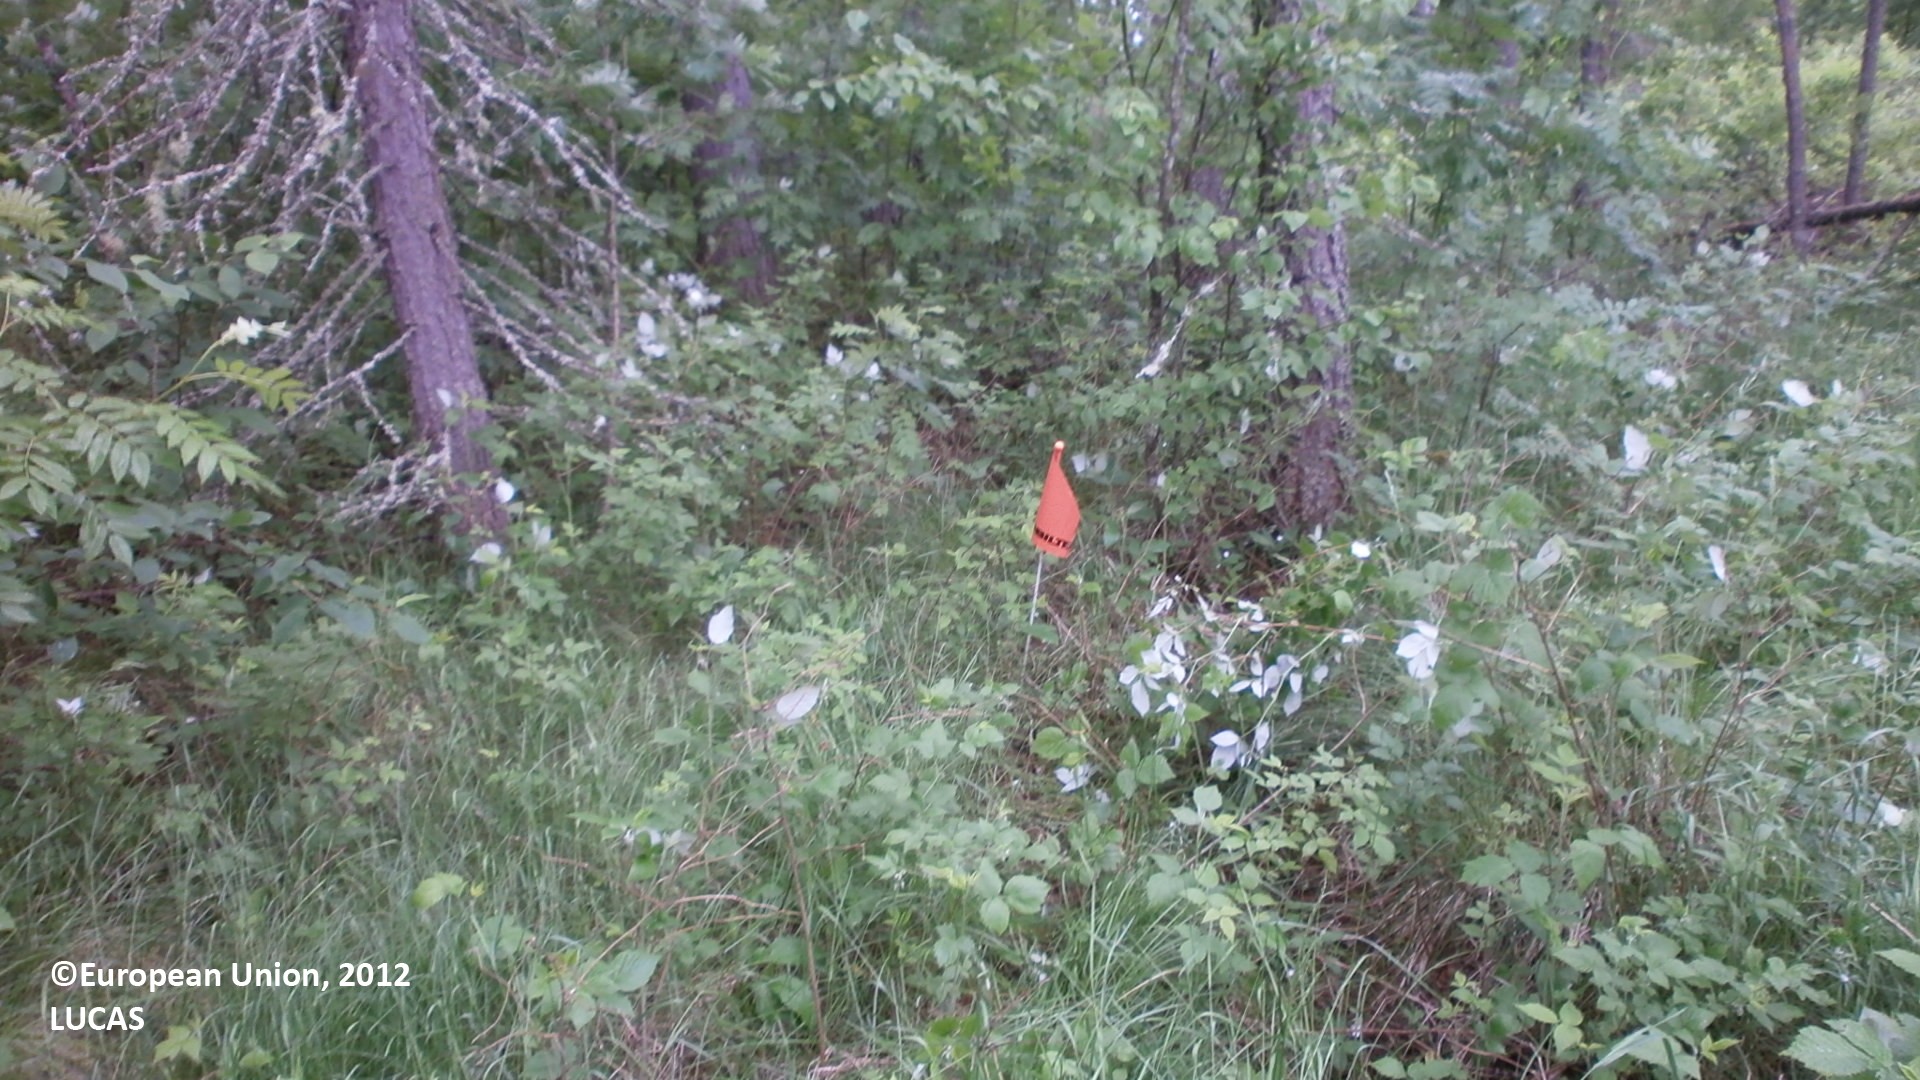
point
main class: Woodland
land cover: Other coniferous woodland
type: boreal forest
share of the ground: 50 - 75 %
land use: Forestry
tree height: > 5 m
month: June
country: FI
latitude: 64.6144
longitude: 25.0687
